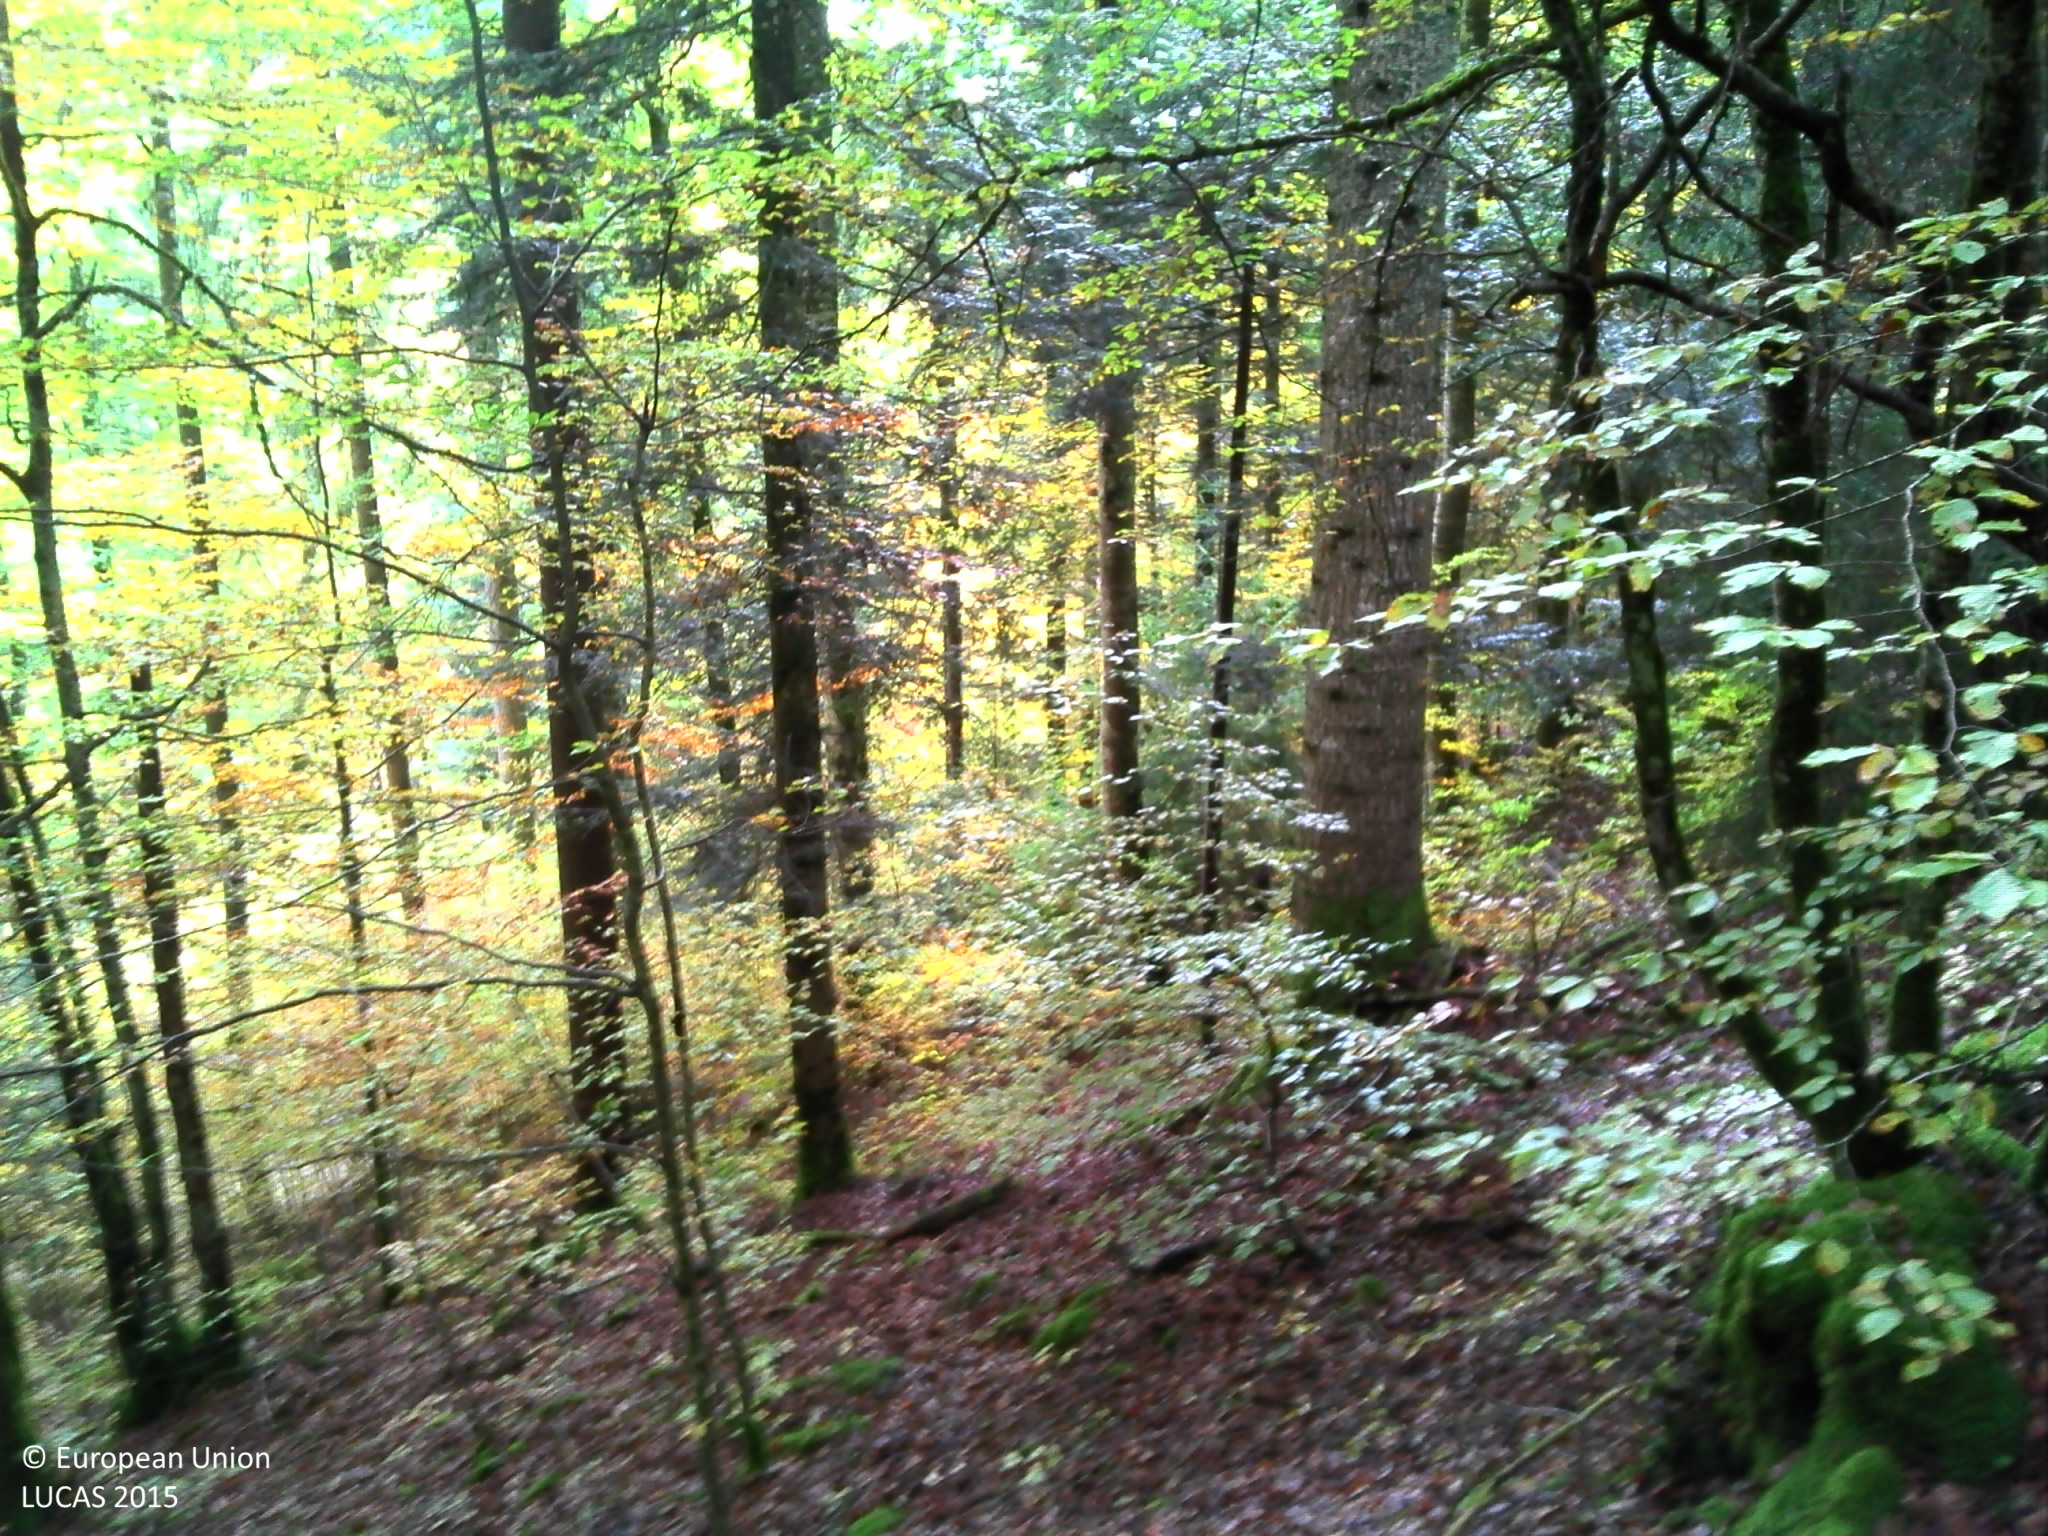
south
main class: Woodland
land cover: Spruce dominated mixed woodland
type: mountainous beech forest
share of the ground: 50 - 75 %
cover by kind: broadleaved forest trees 40 %, coniferous forest trees 30 %, unconsolidated bare surface 20 %, lichens and mosses 5 %, consolidated bare surface 5 %
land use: Forestry
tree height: > 5 m
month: October
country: FR
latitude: 46.7594
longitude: 6.4022
